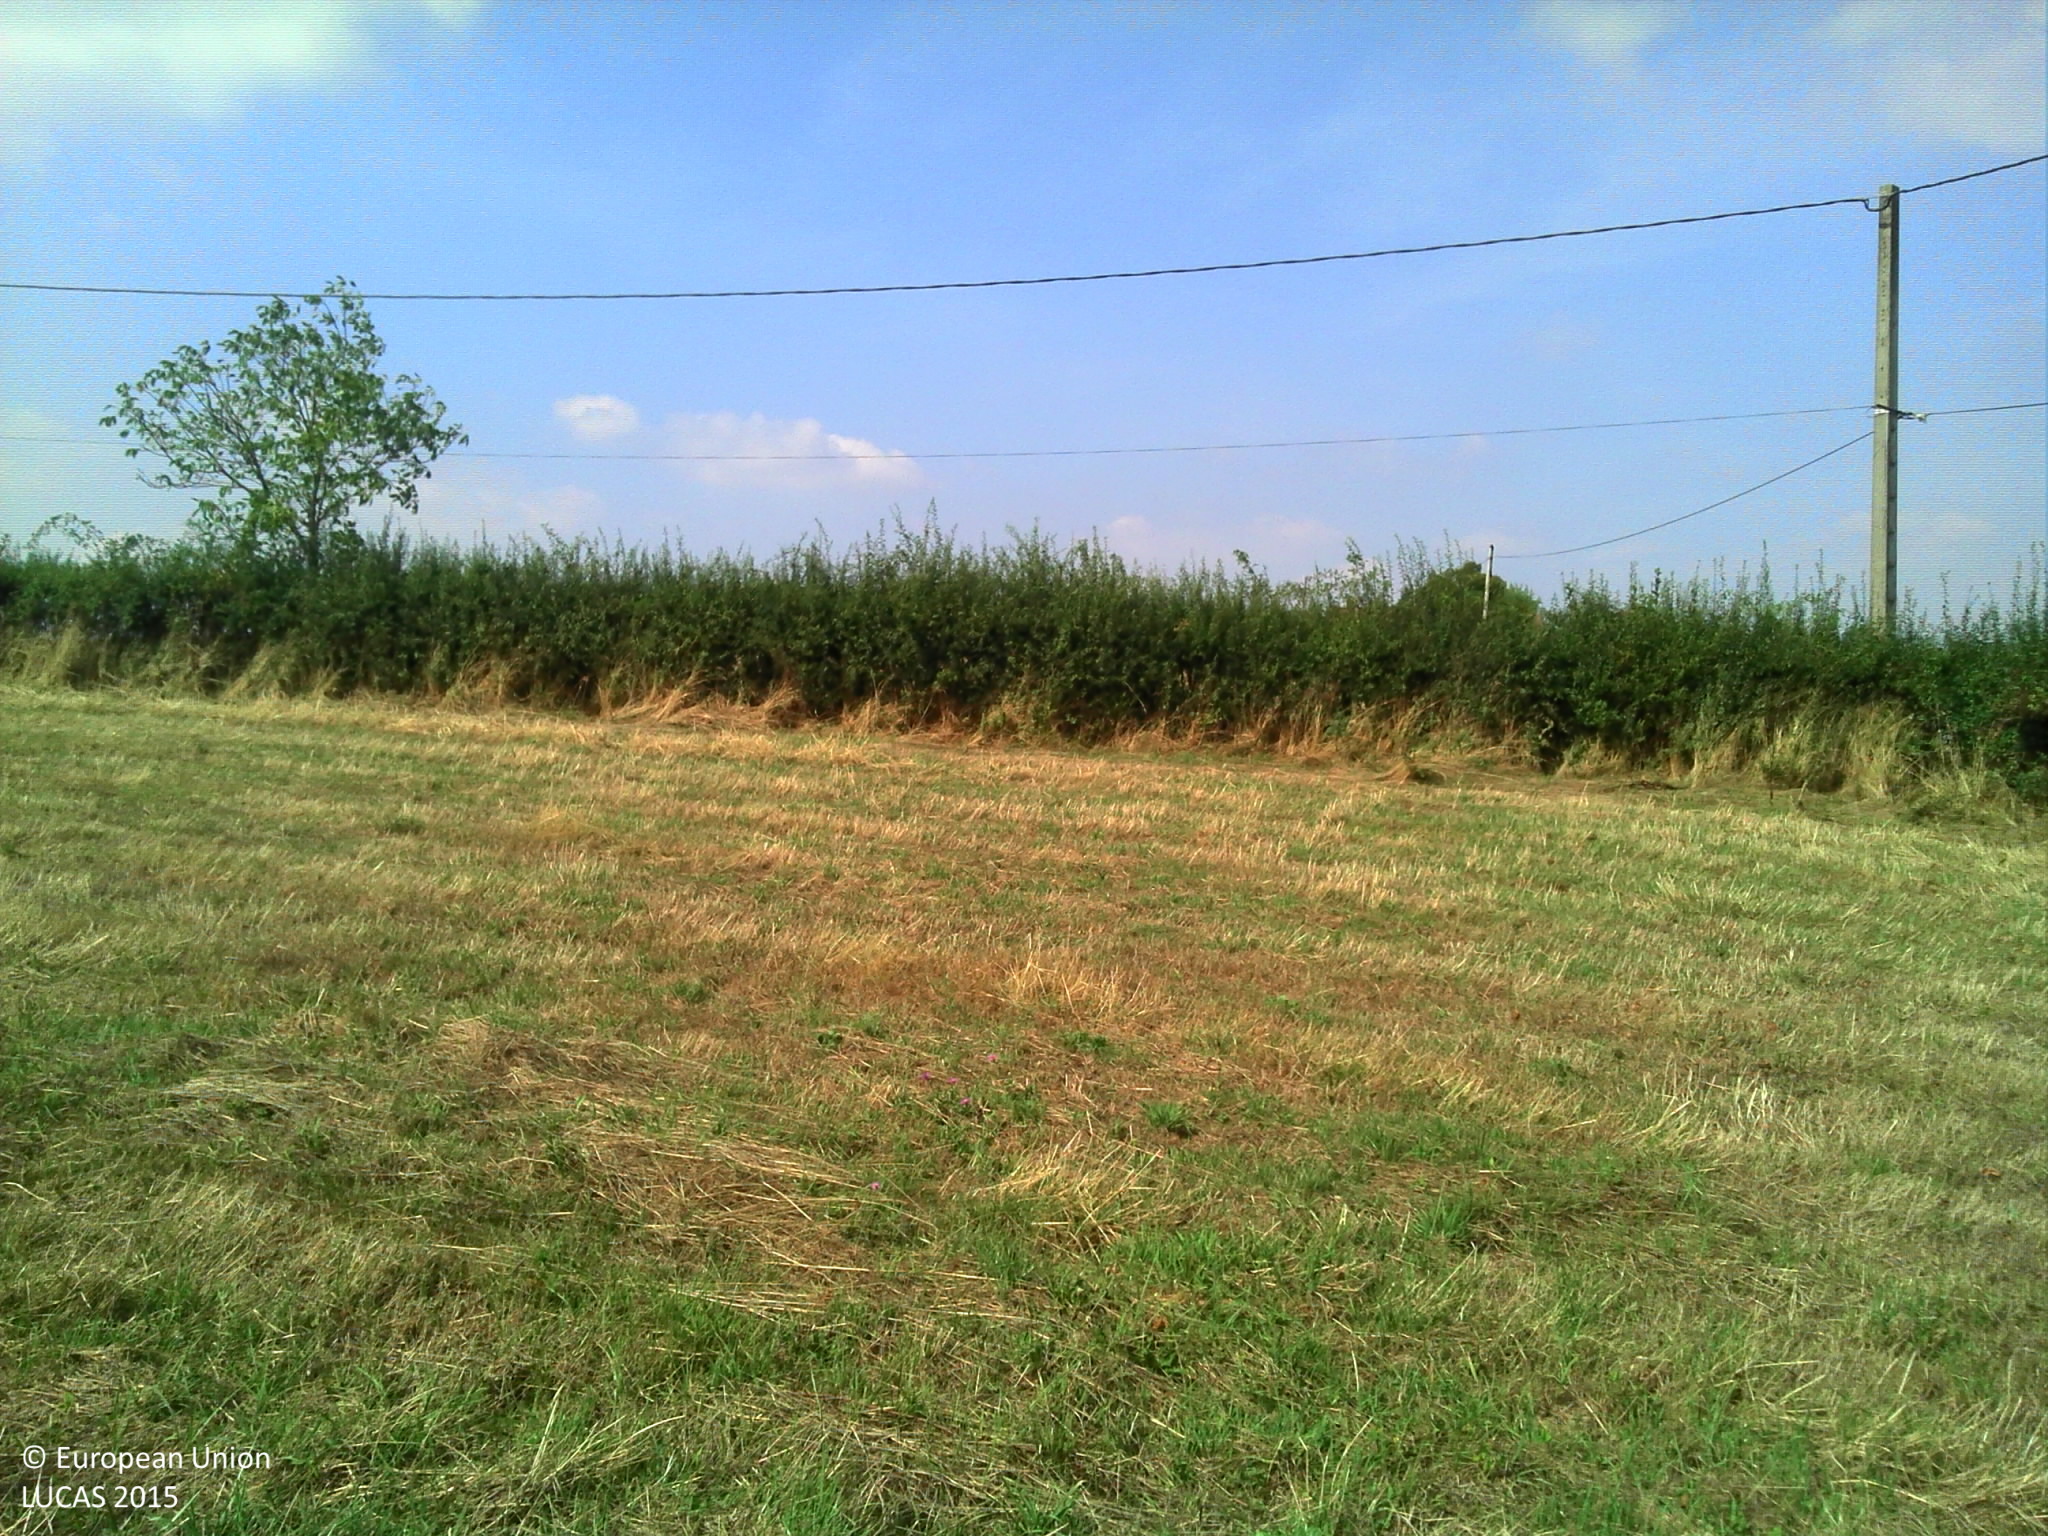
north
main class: Grassland
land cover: Grassland without tree/shrub cover
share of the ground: > 75 %
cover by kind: herbaceous plants 100 %
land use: Agriculture (excluding fallow land and kitchen gardens)
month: August
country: FR
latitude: 46.3803
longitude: 3.6678
